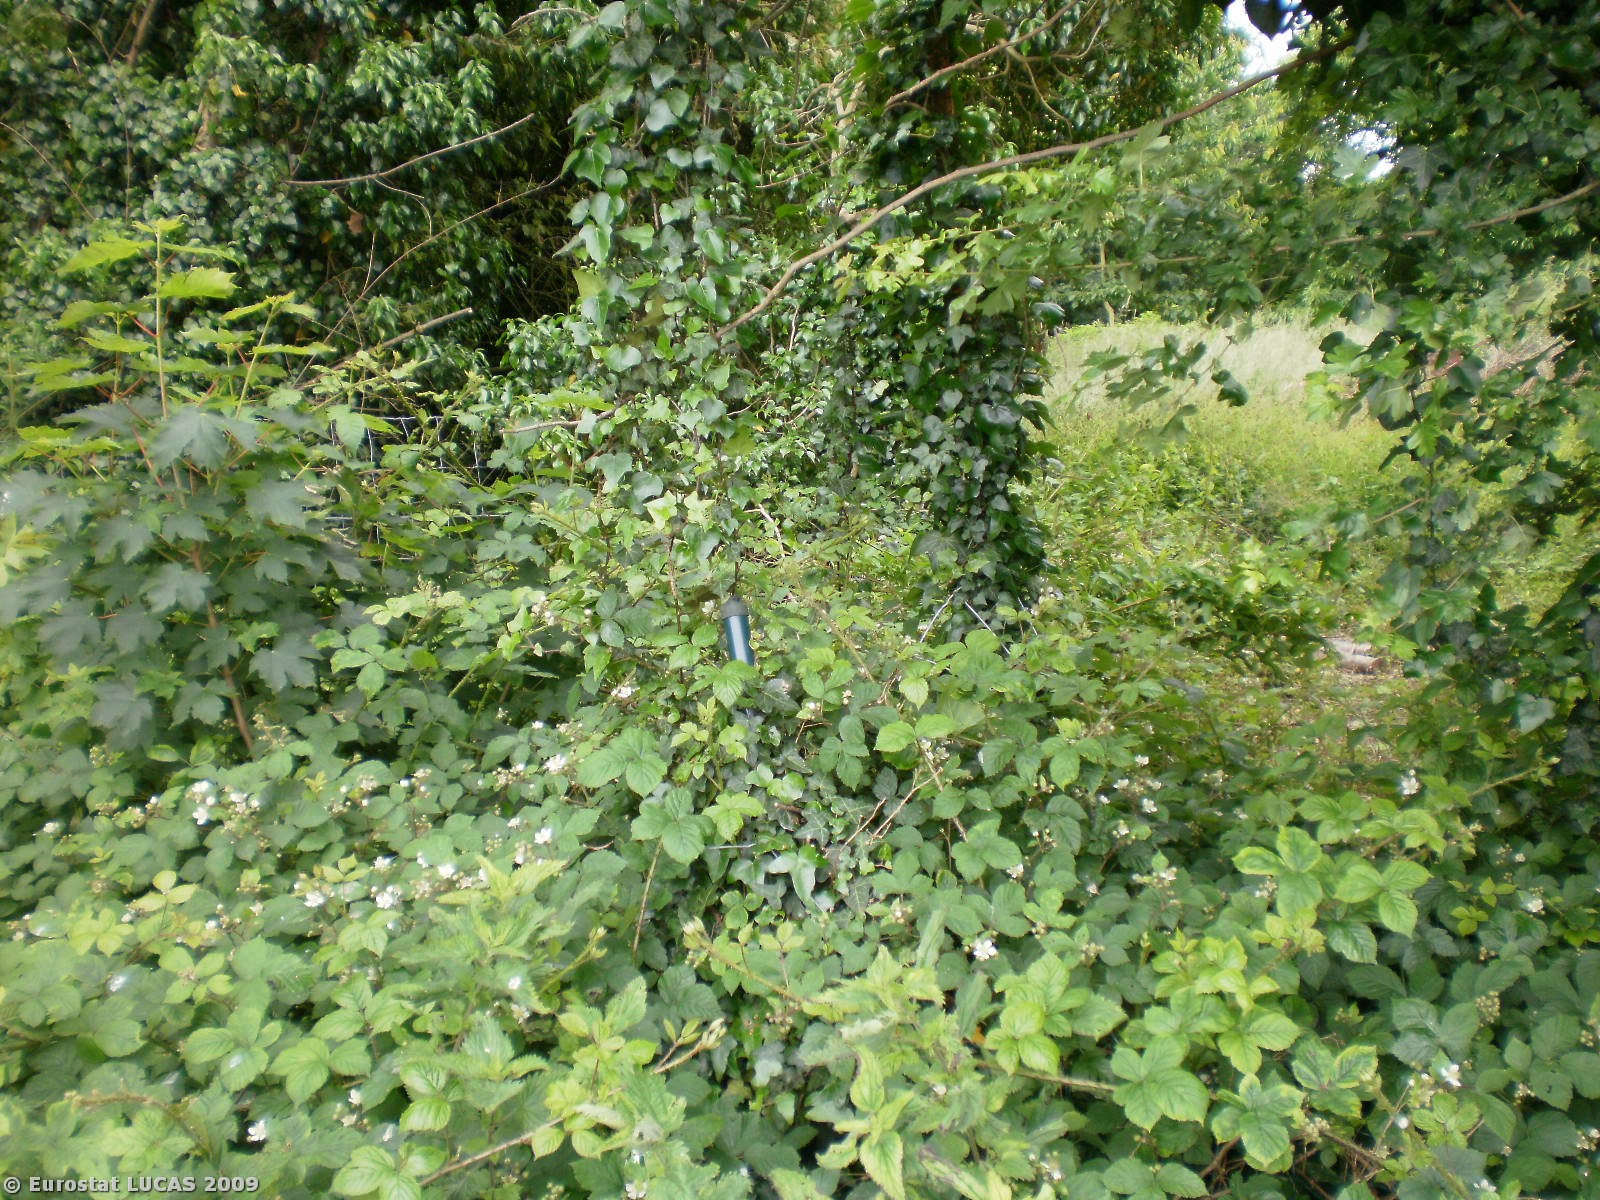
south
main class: Woodland
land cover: Broadleaved woodland
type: mesophytic deciduous forest
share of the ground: 50 - 75 %
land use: Unused
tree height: > 5 m
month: June
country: BE
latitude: 50.4131
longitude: 3.8158
